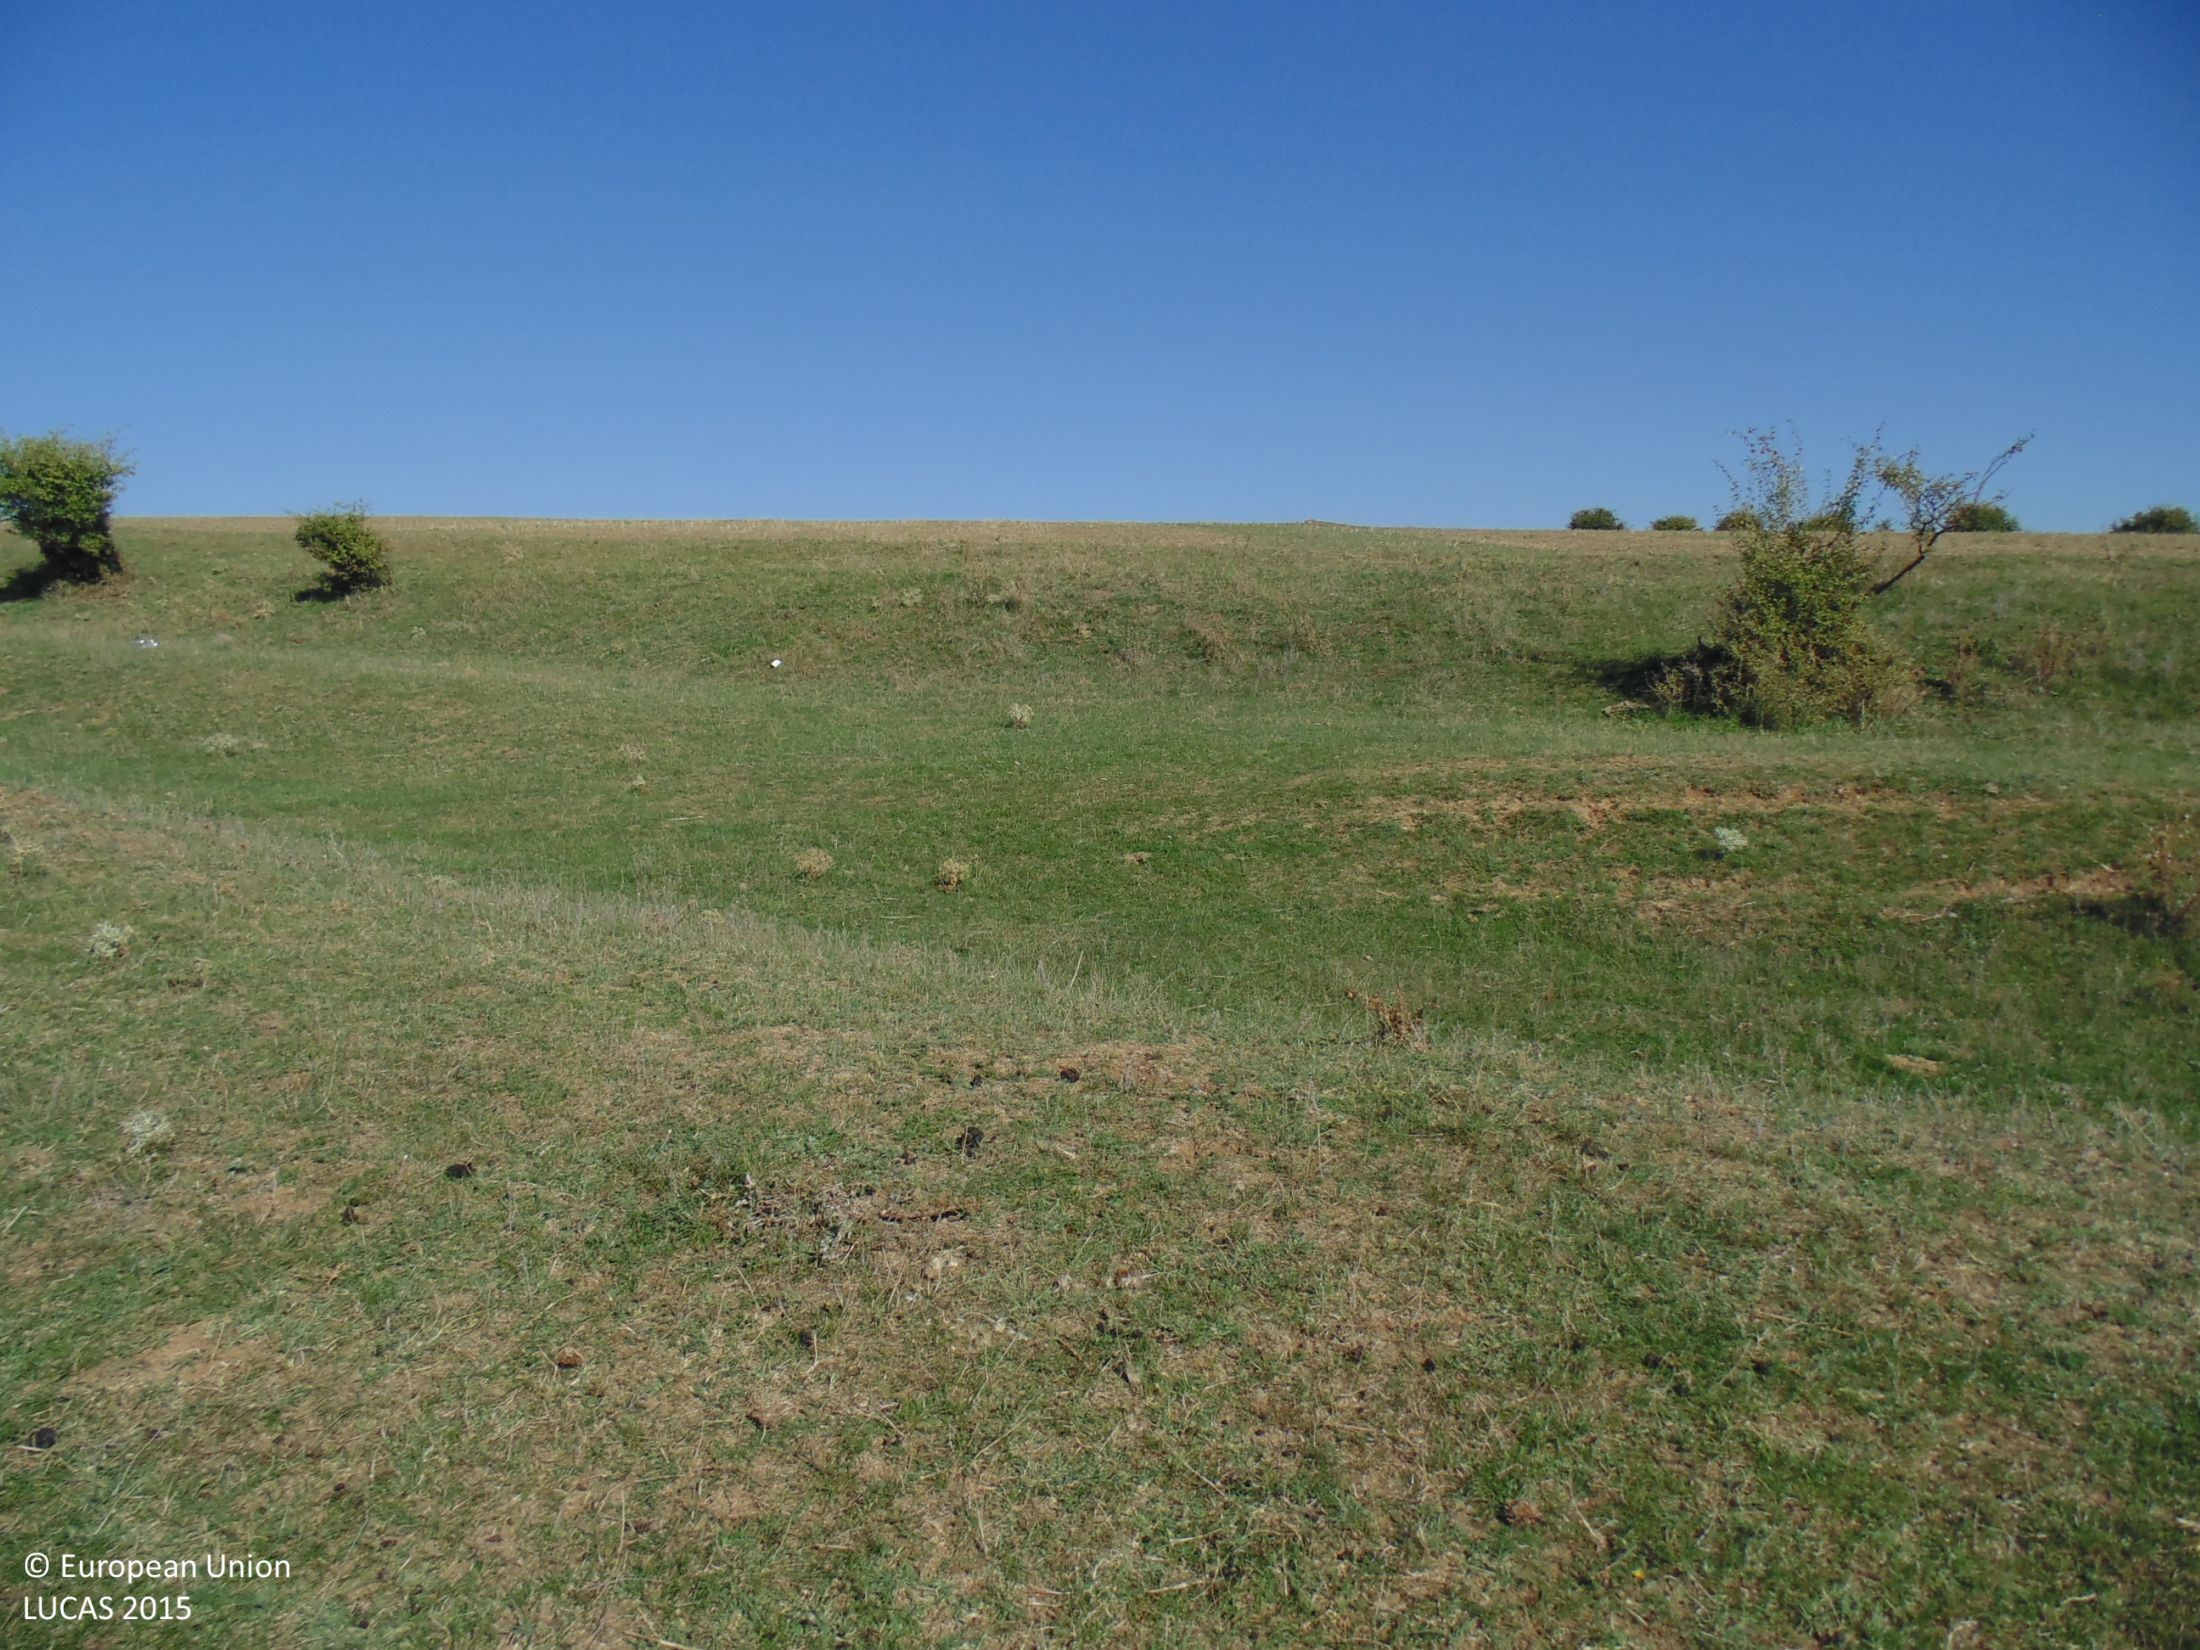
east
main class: Grassland
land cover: Grassland without tree/shrub cover
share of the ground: > 75 %
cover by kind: herbaceous plants 100 %
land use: Agriculture (excluding fallow land and kitchen gardens)
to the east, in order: Grassland without tree/shrub cover; Common wheat
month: September
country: BG
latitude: 43.7251
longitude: 27.1176
